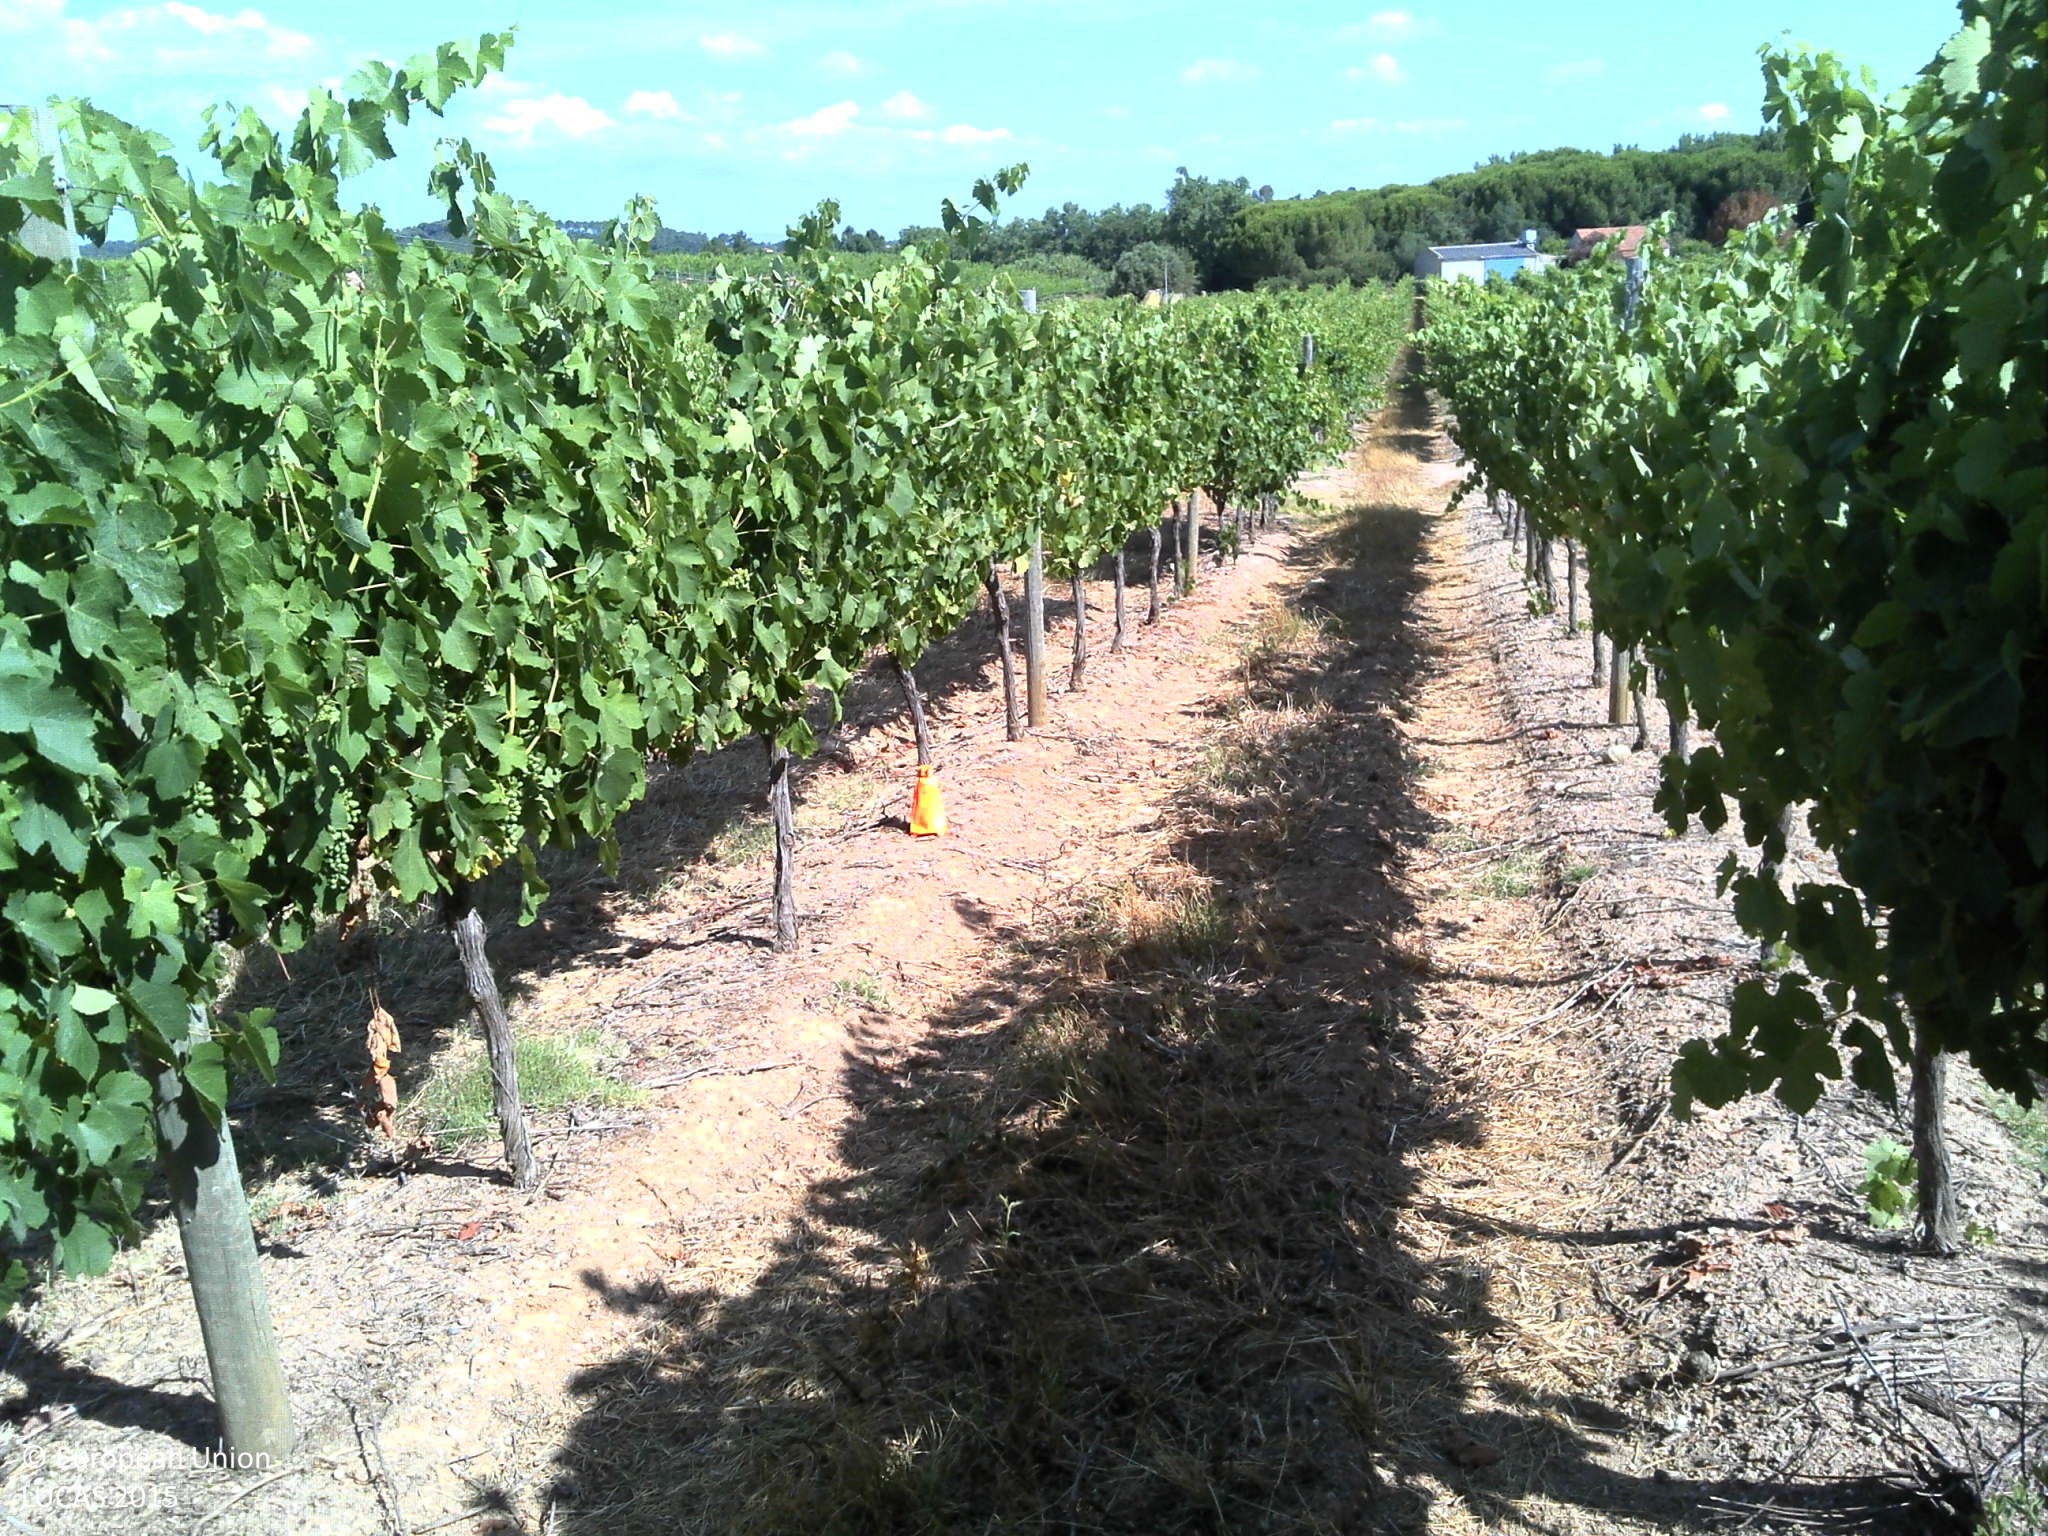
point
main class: Cropland
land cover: Vineyards
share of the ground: 50 - 75 %
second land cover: Grassland without tree/shrub cover
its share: 25 - 50 %
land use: Agriculture (excluding fallow land and kitchen gardens)
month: July
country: PT
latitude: 38.4762
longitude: -9.0379
